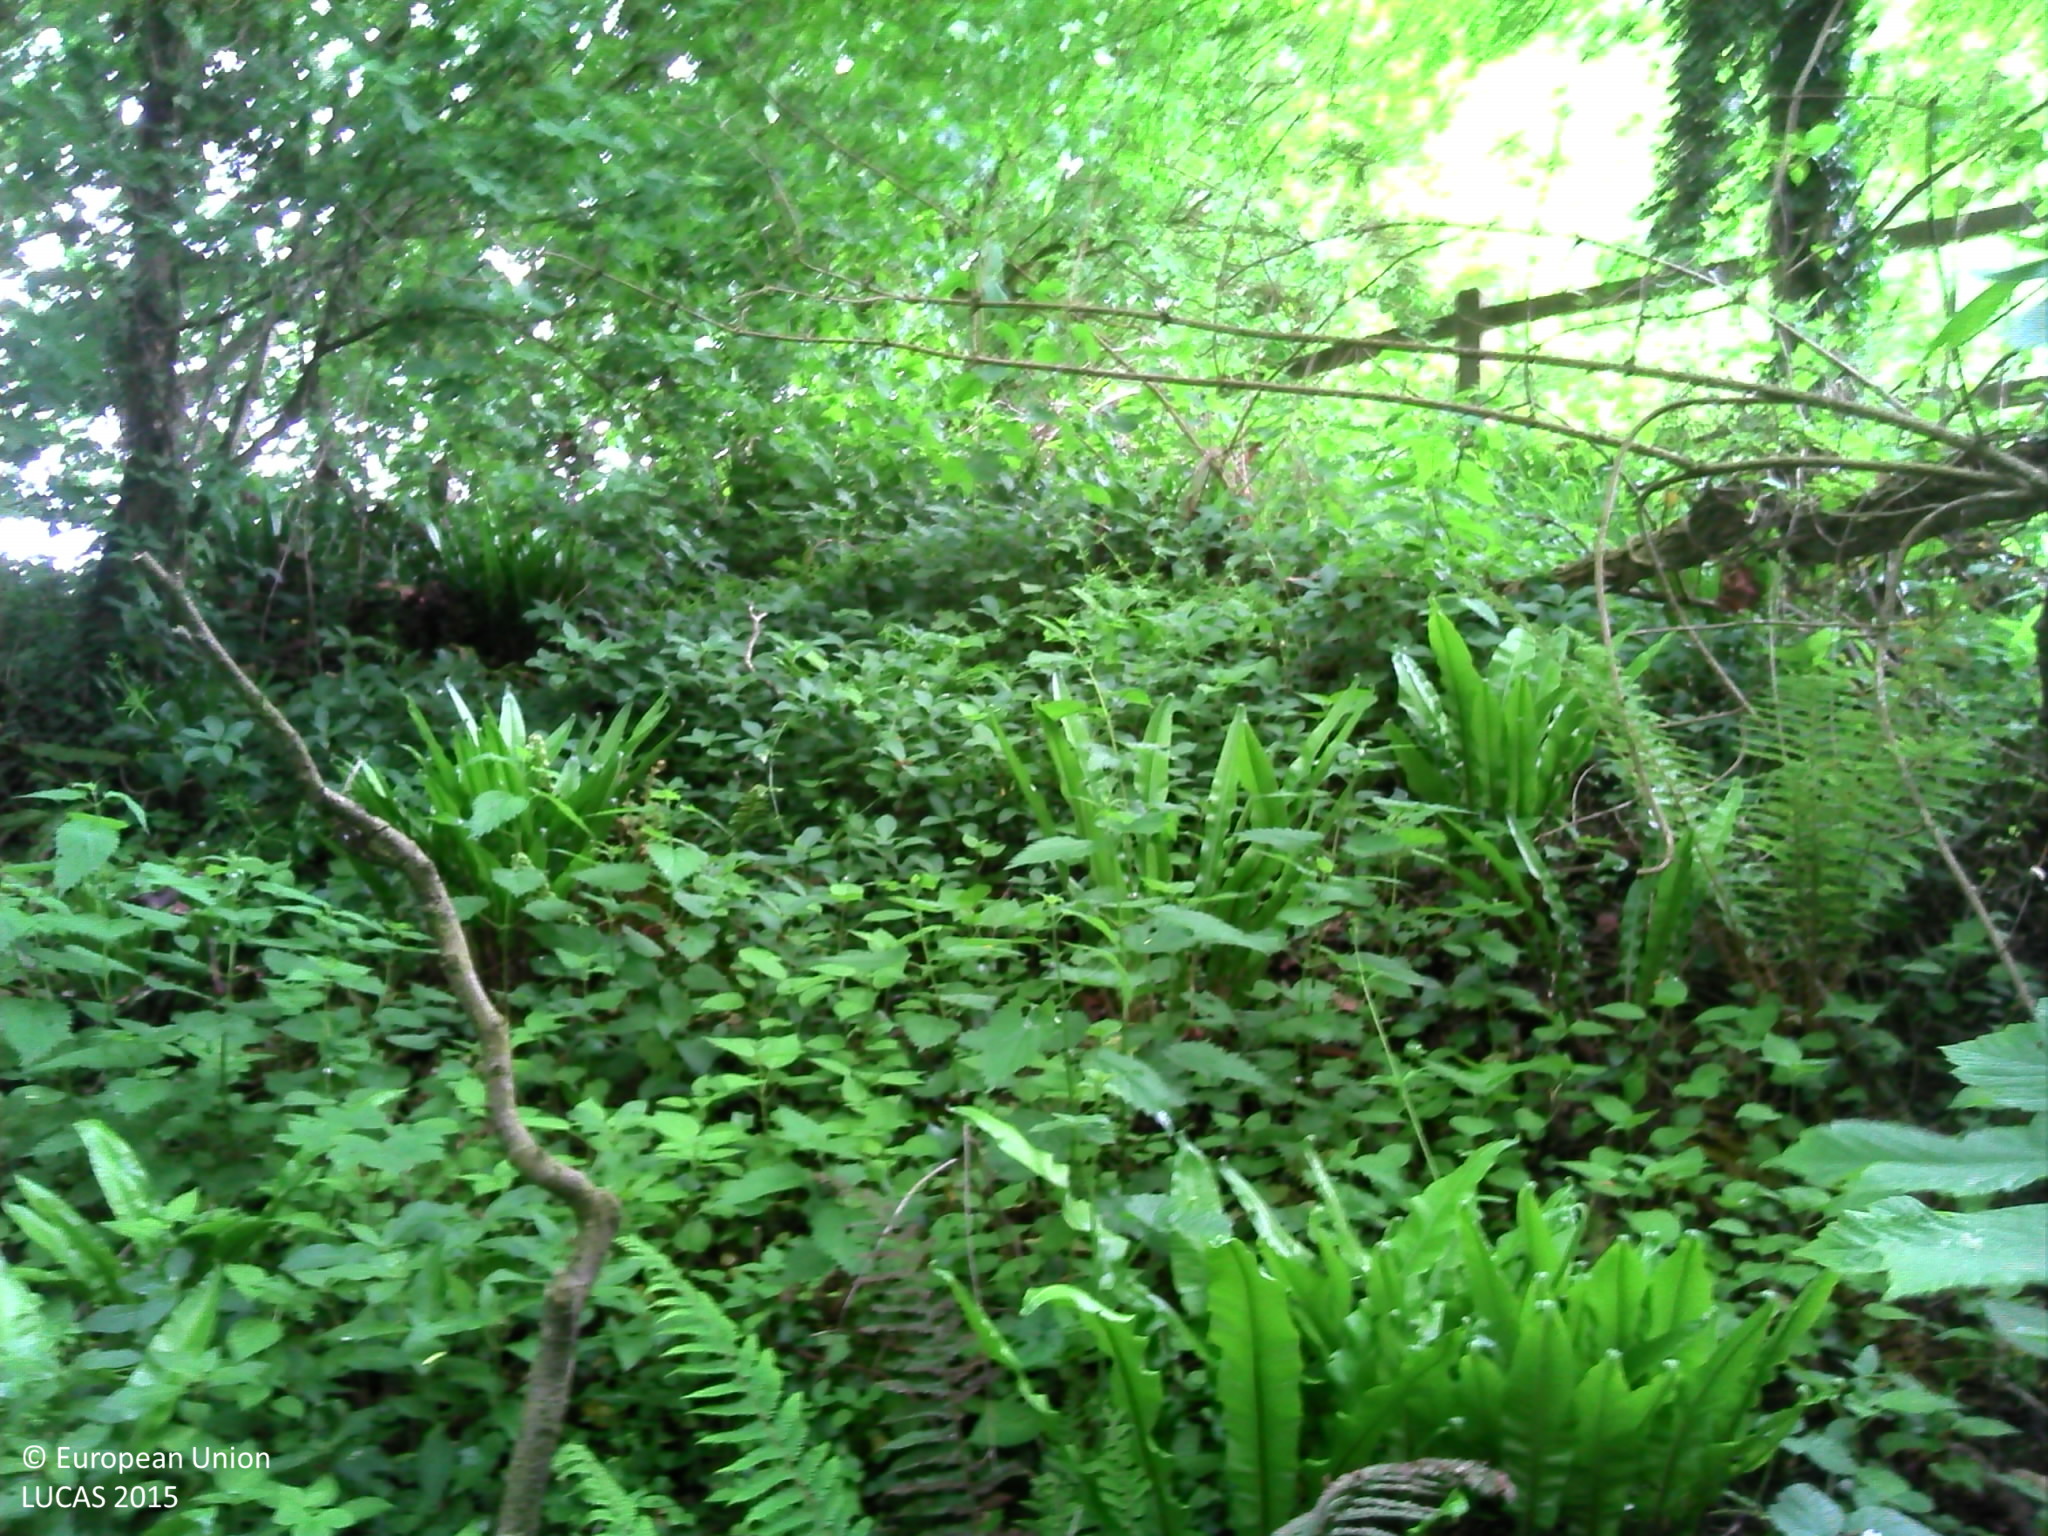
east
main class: Woodland
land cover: Broadleaved woodland
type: mesophytic deciduous forest
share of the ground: > 75 %
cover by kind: broadleaved forest trees 80 %, shrubs 15 %, herbaceous plants 5 %
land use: Semi-natural and natural areas not in use
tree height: > 5 m
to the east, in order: Broadleaved woodland; Fences; Grassland without tree/shrub cover; Fences; Grassland without tree/shrub cover; Tracks; Grassland without tree/shrub cover; Artificial constructions in urban areas
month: May
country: FR
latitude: 49.2856
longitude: -0.0539
